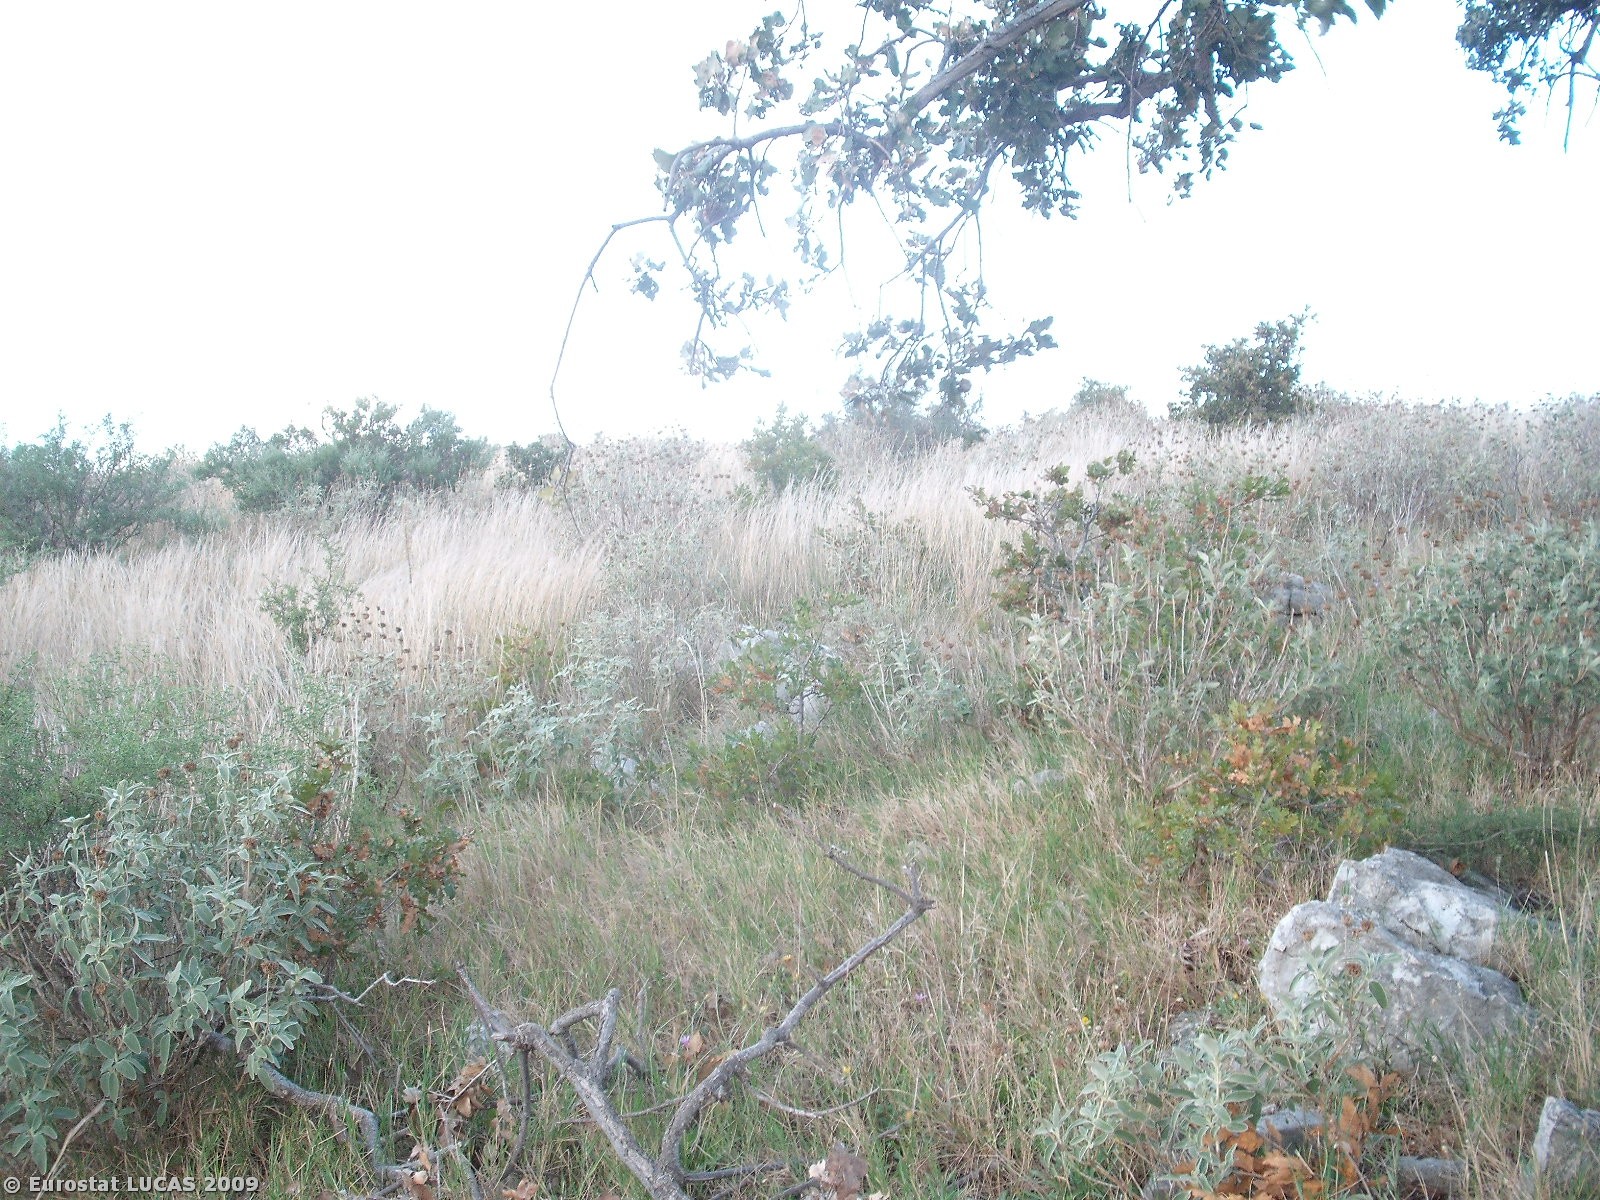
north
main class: Shrubland
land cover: Shrubland without tree cover
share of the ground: > 75 %
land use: Nature reserves
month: October
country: GR
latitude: 38.1792
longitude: 21.3690
